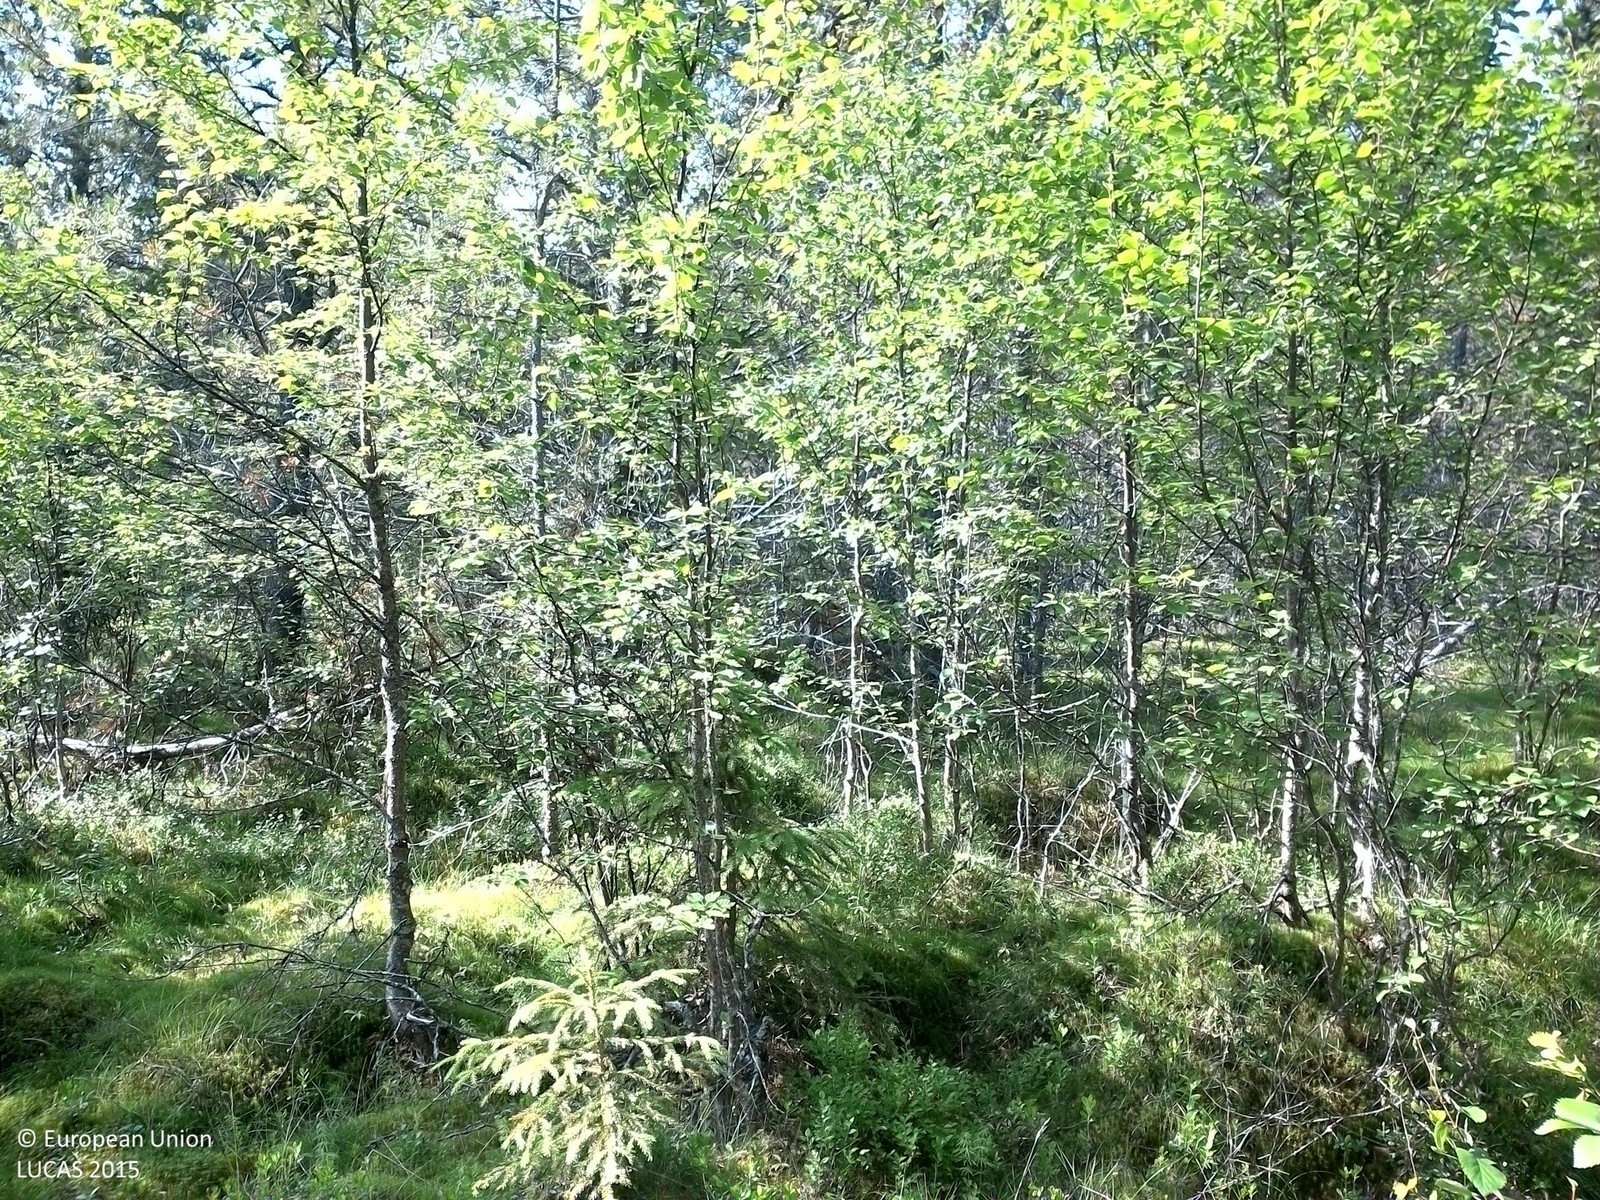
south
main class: Woodland
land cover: Pine dominated mixed woodland
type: exotic forest
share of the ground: 50 - 75 %
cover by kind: coniferous forest trees 50 %, broadleaved forest trees 20 %, shrubs 15 %, herbaceous plants 10 %, lichens and mosses 5 %
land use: Forestry
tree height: > 5 m
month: July
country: SE
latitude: 63.5542
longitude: 17.4000
